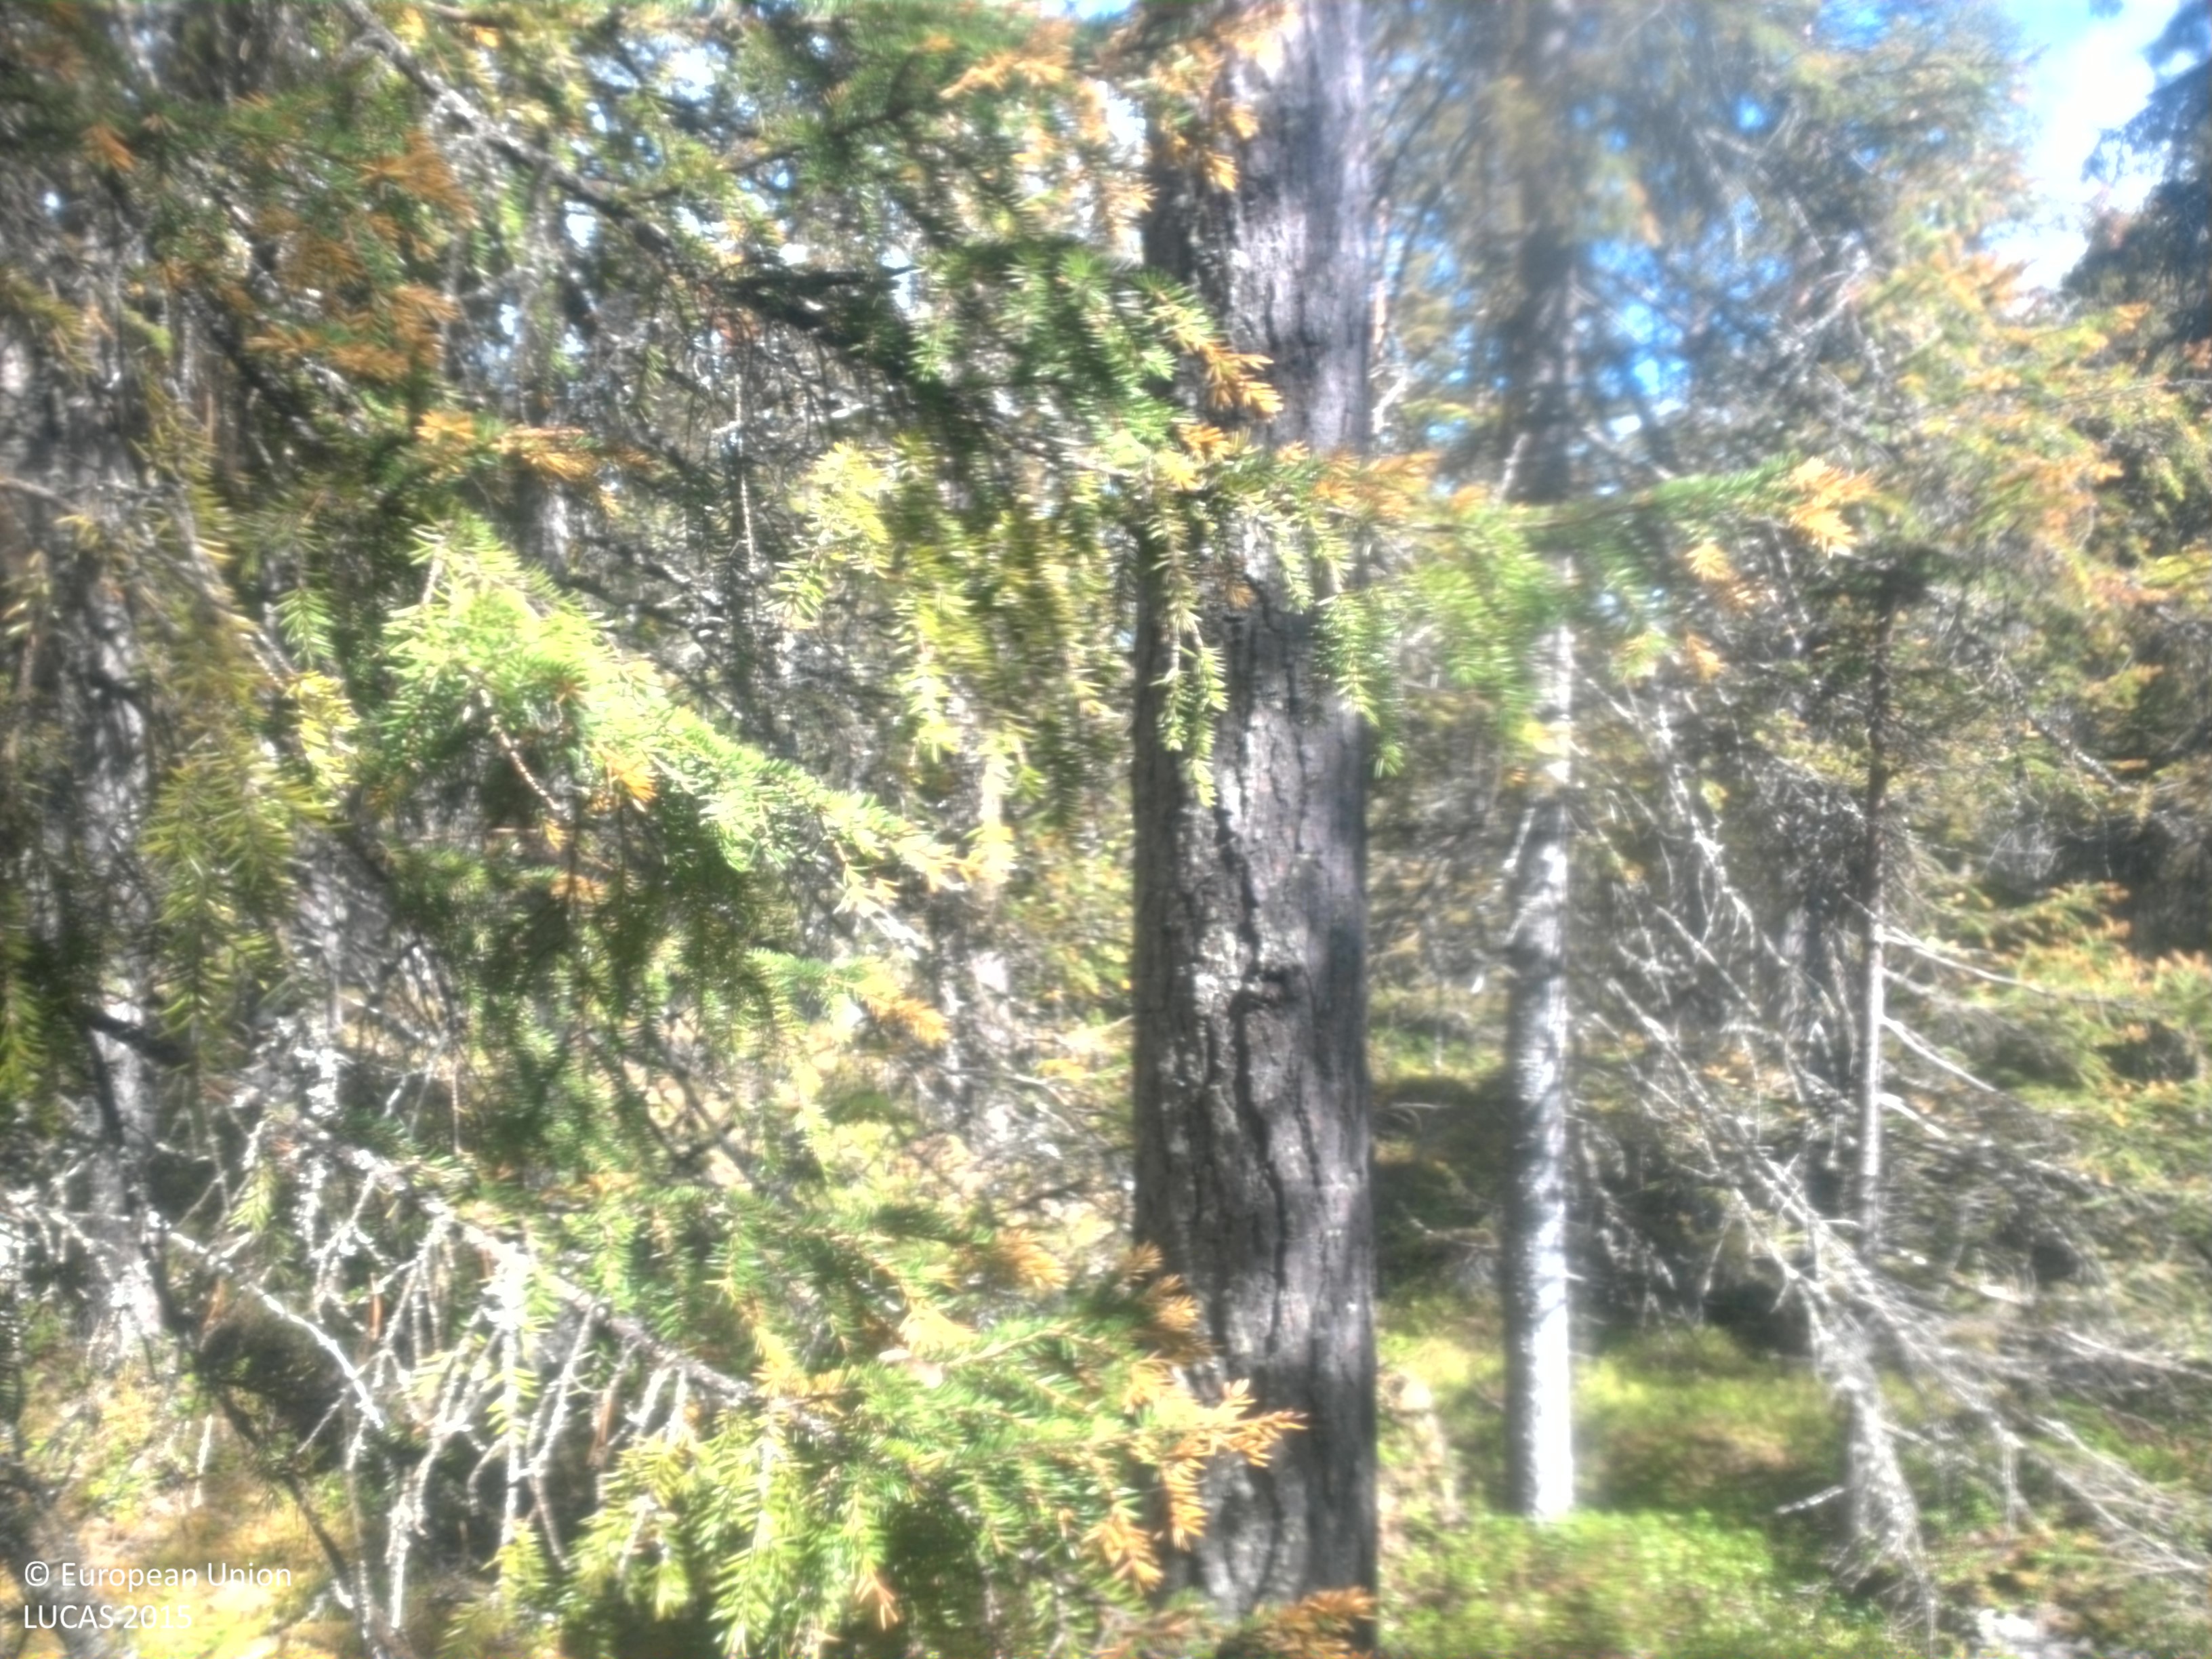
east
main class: Woodland
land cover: Pine dominated coniferous woodland
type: boreal forest
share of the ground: 50 - 75 %
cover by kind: coniferous forest trees 50 %, herbaceous plants 25 %, lichens and mosses 10 %, broadleaved forest trees 5 %, shrubs 5 %, unconsolidated bare surface 5 %
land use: Forestry
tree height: > 5 m
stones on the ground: 25 - 50 %
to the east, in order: Pine dominated coniferous woodland; Spruce dominated mixed woodland; Rocks and stones; Rivers and streams; Spruce dominated mixed woodland; Pine dominated mixed woodland; Shrubland with sparse tree cover
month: June
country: SE
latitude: 64.3368
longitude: 17.7292
